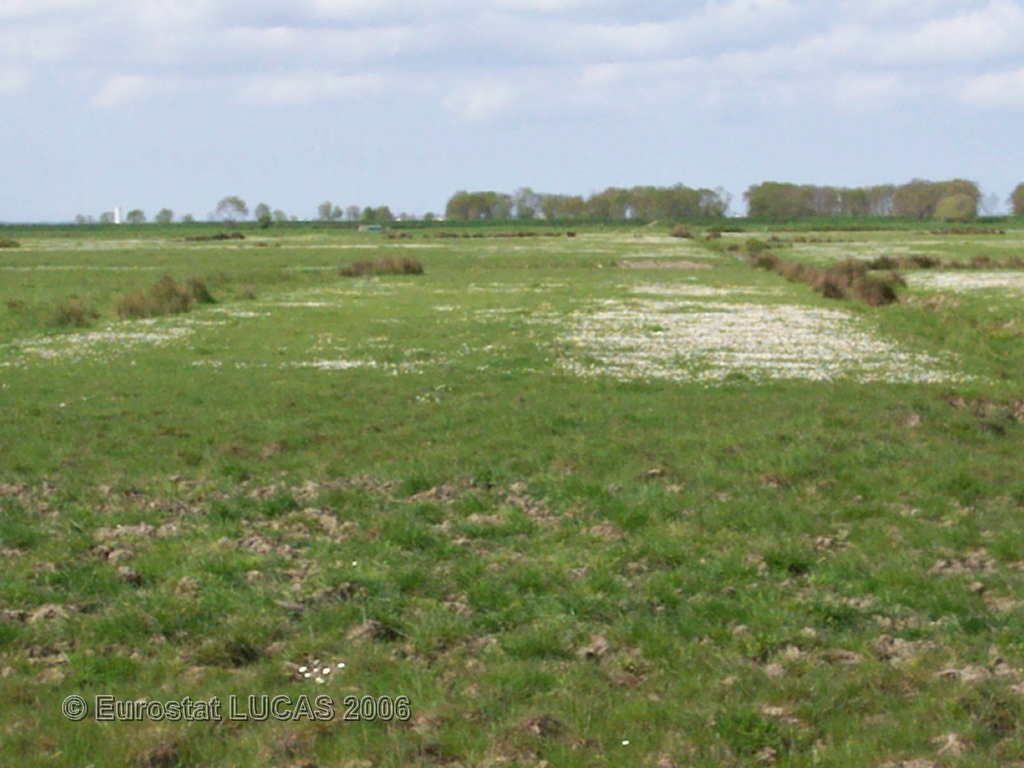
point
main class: Grassland
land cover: Grassland without tree/shrub cover
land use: Agriculture (excluding fallow land and kitchen gardens)
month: April
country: FR
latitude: 45.3045
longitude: -0.6972
